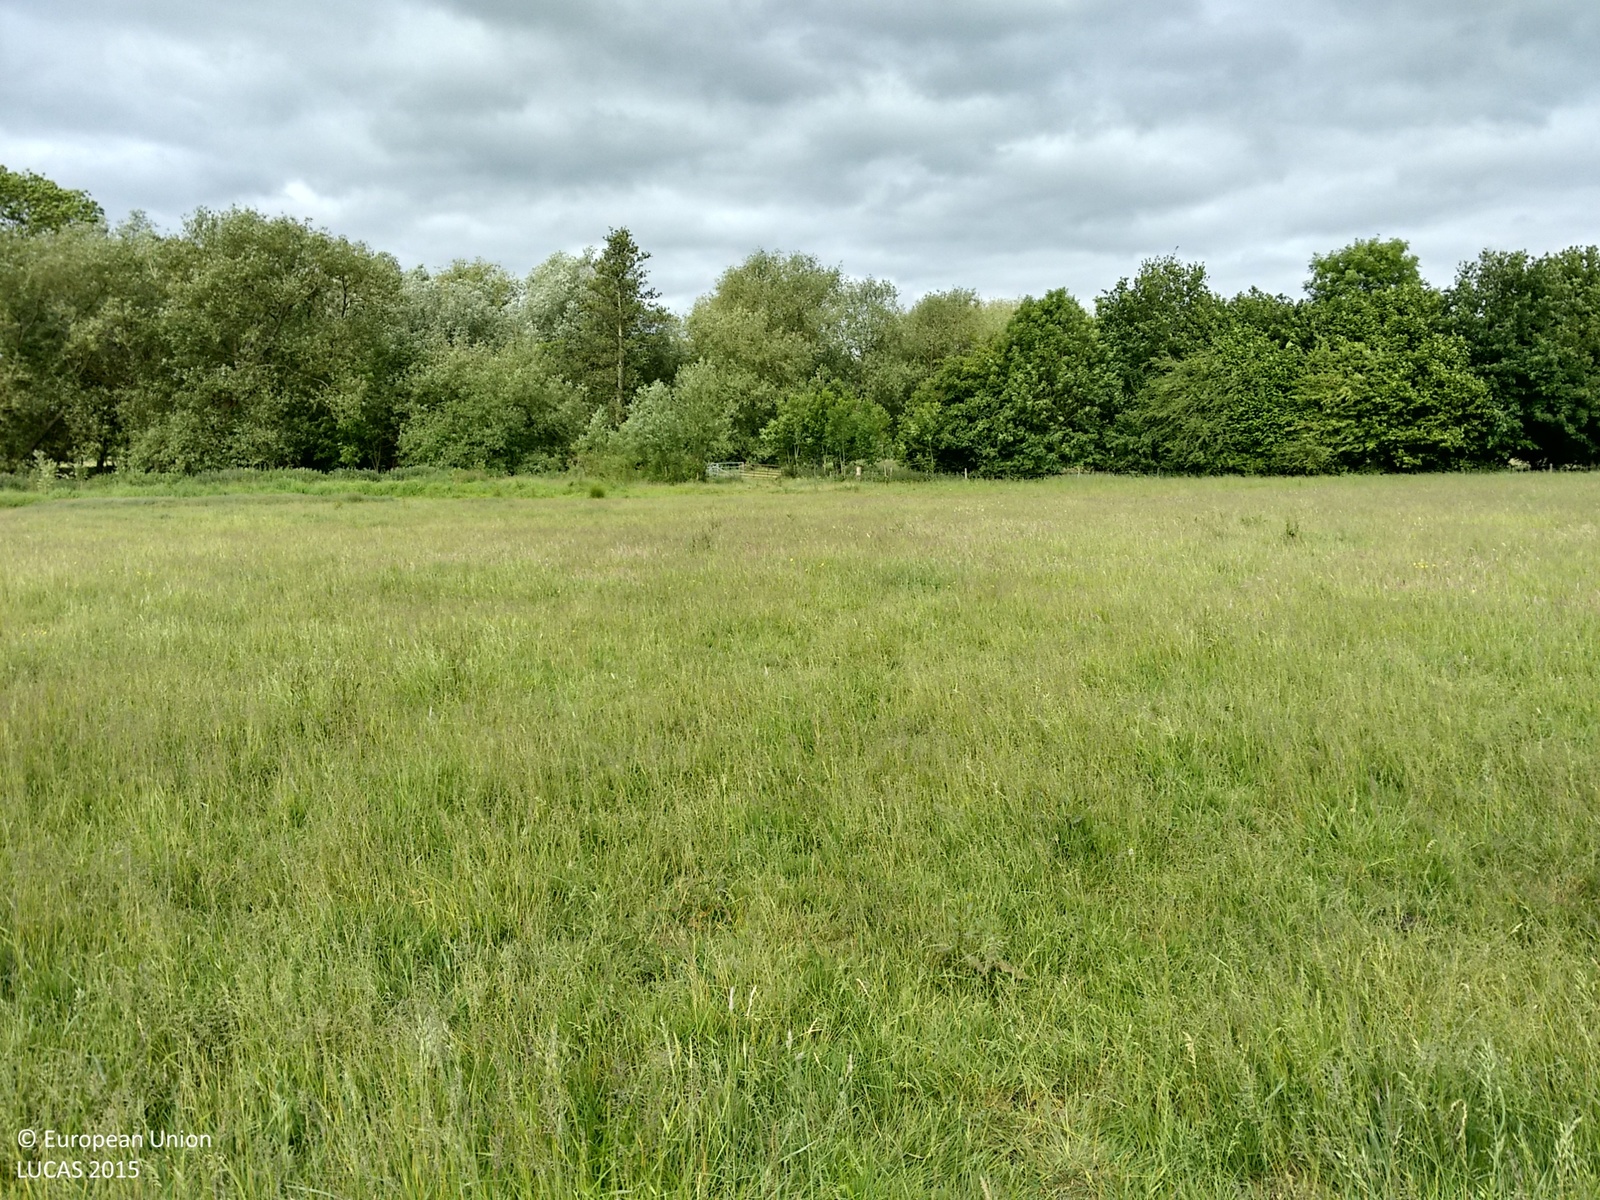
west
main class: Grassland
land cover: Grassland without tree/shrub cover
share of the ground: > 75 %
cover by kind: herbaceous plants 100 %
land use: Agriculture (excluding fallow land and kitchen gardens)
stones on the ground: < 10 %
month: June
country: GB
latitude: 51.5479
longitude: -0.6976
